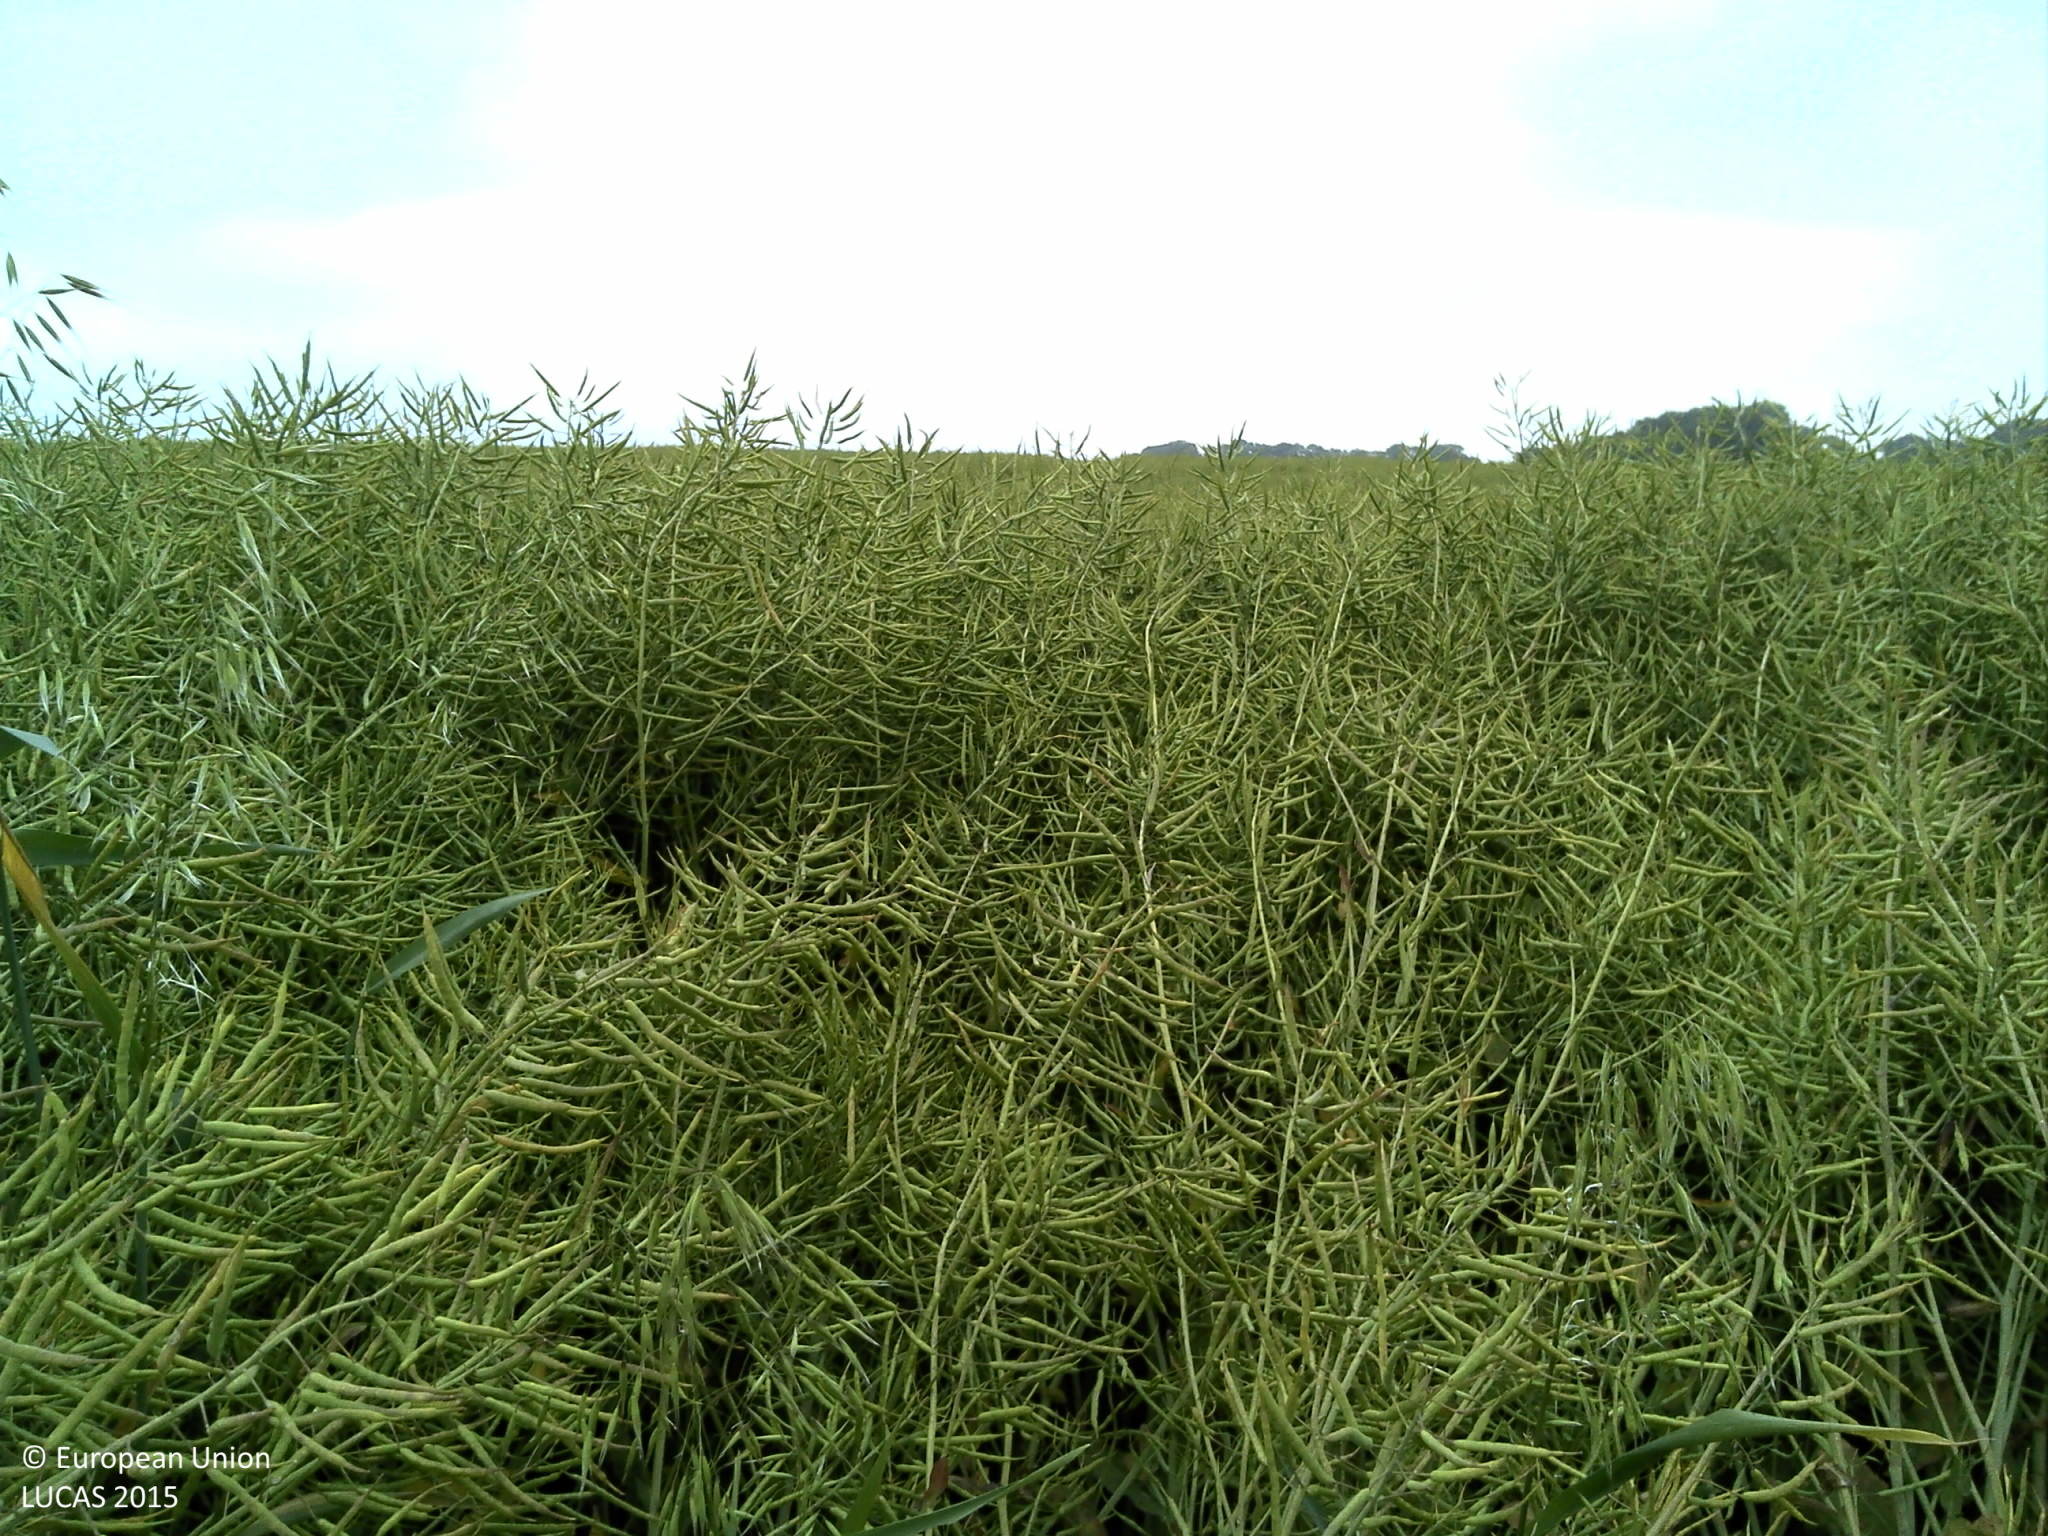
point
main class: Cropland
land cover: Rape and turnip rape
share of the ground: > 75 %
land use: Agriculture (excluding fallow land and kitchen gardens)
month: June
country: FR
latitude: 49.6624
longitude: 0.3151
